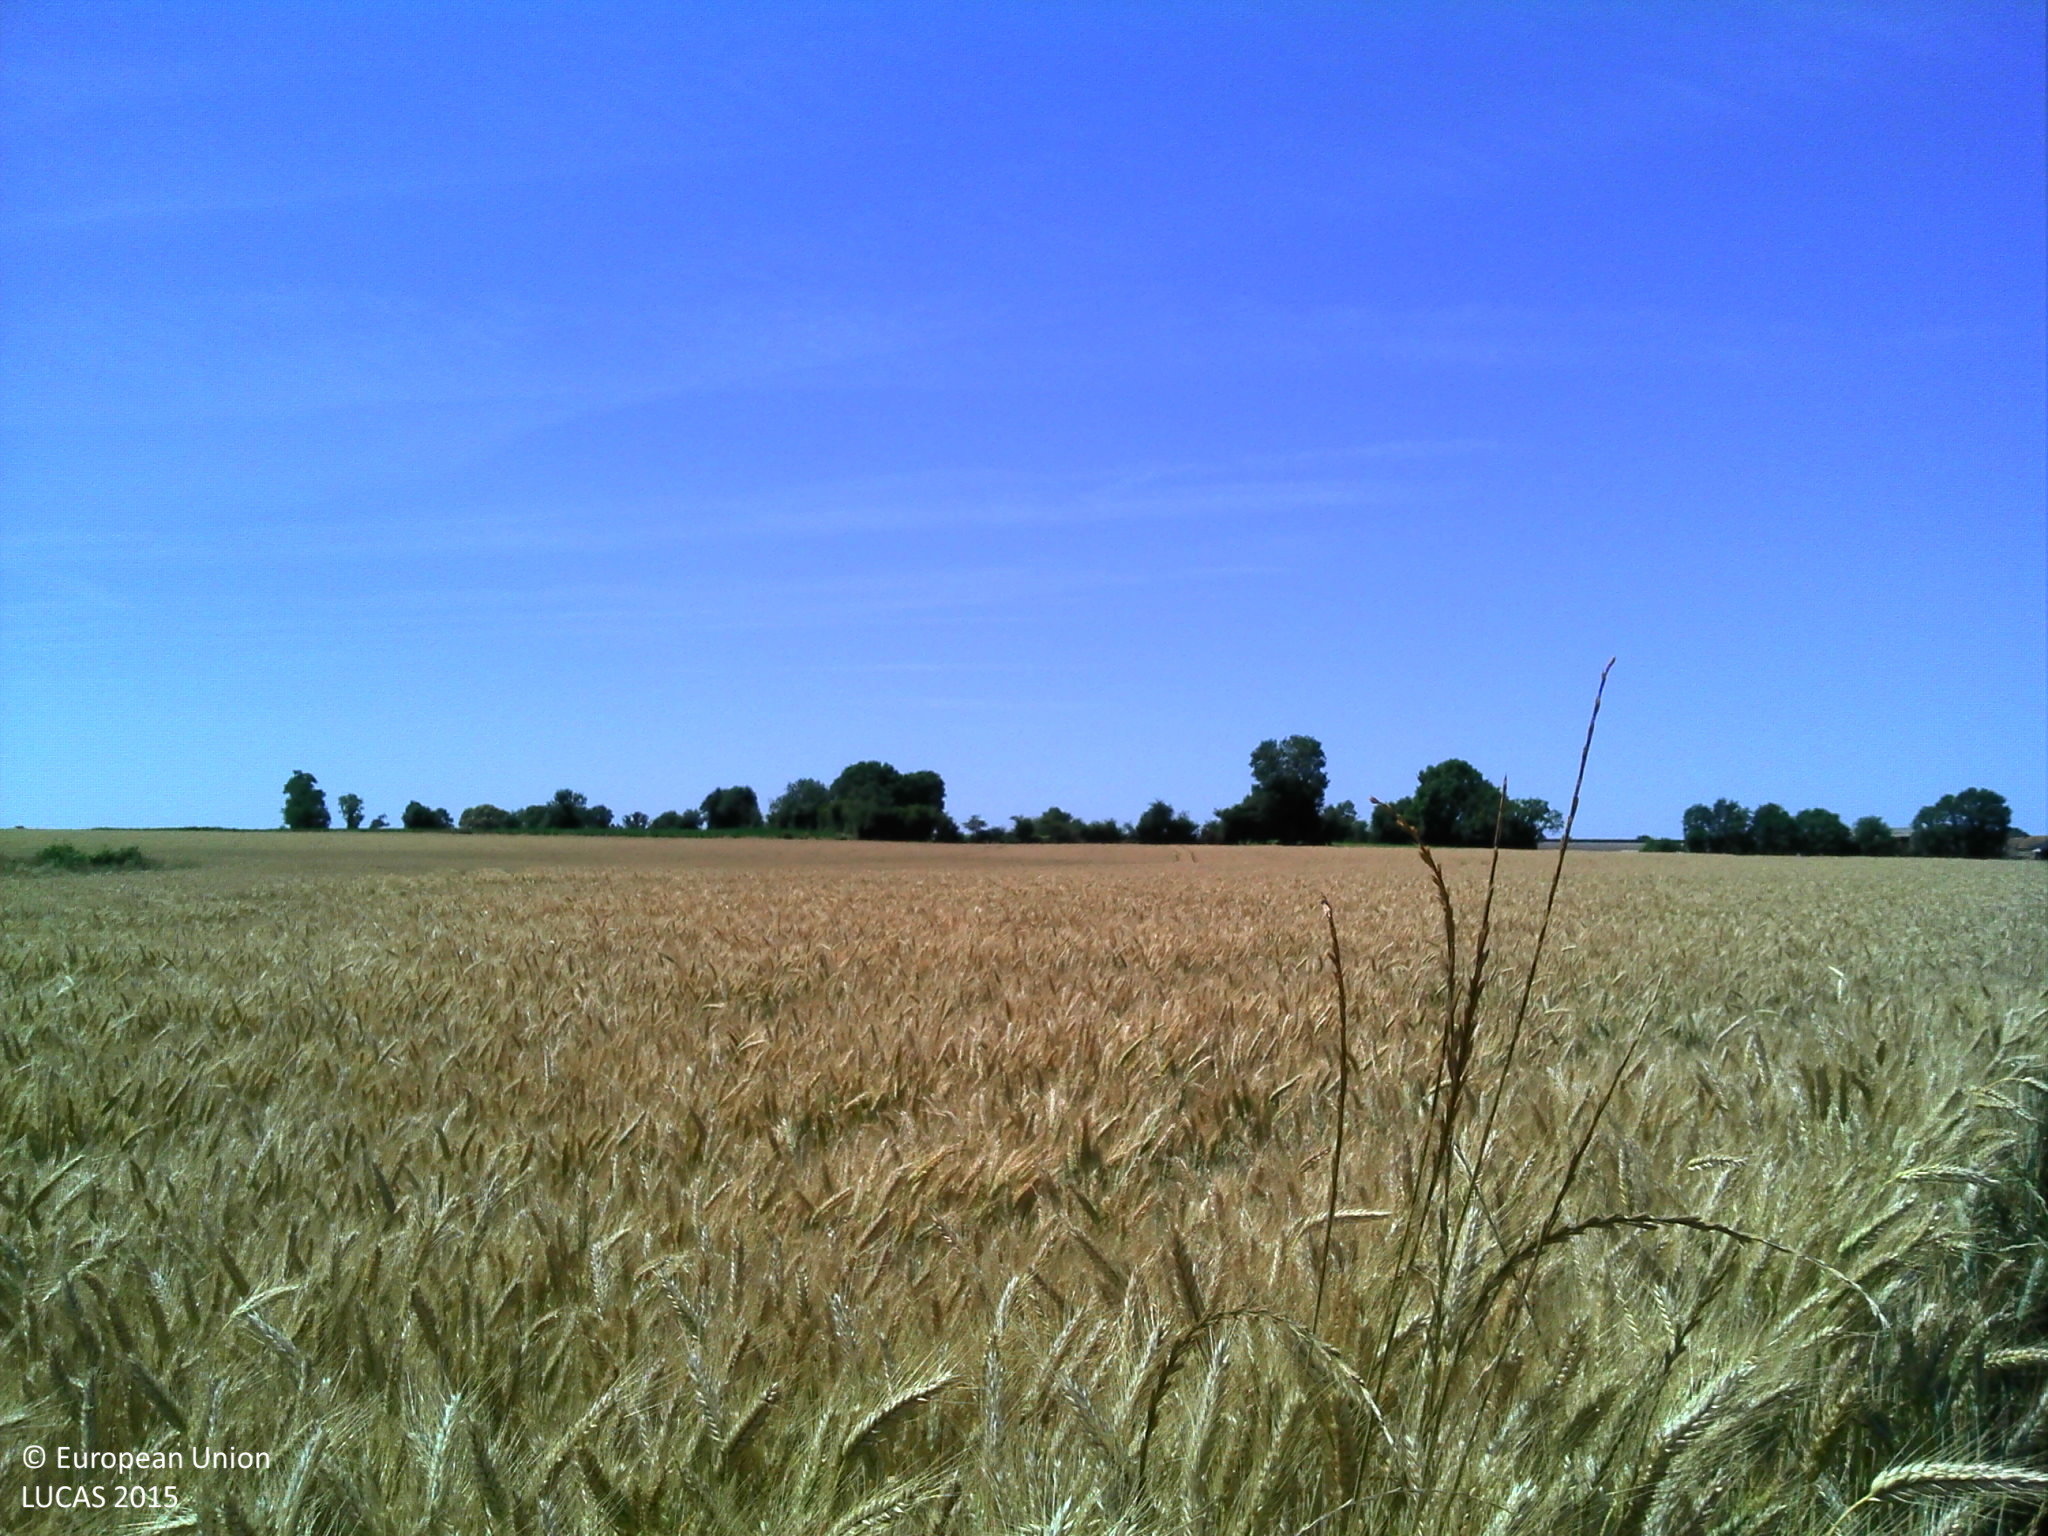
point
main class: Cropland
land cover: Durum wheat
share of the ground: > 75 %
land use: Agriculture (excluding fallow land and kitchen gardens)
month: July
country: FR
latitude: 48.2146
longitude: 0.5420
